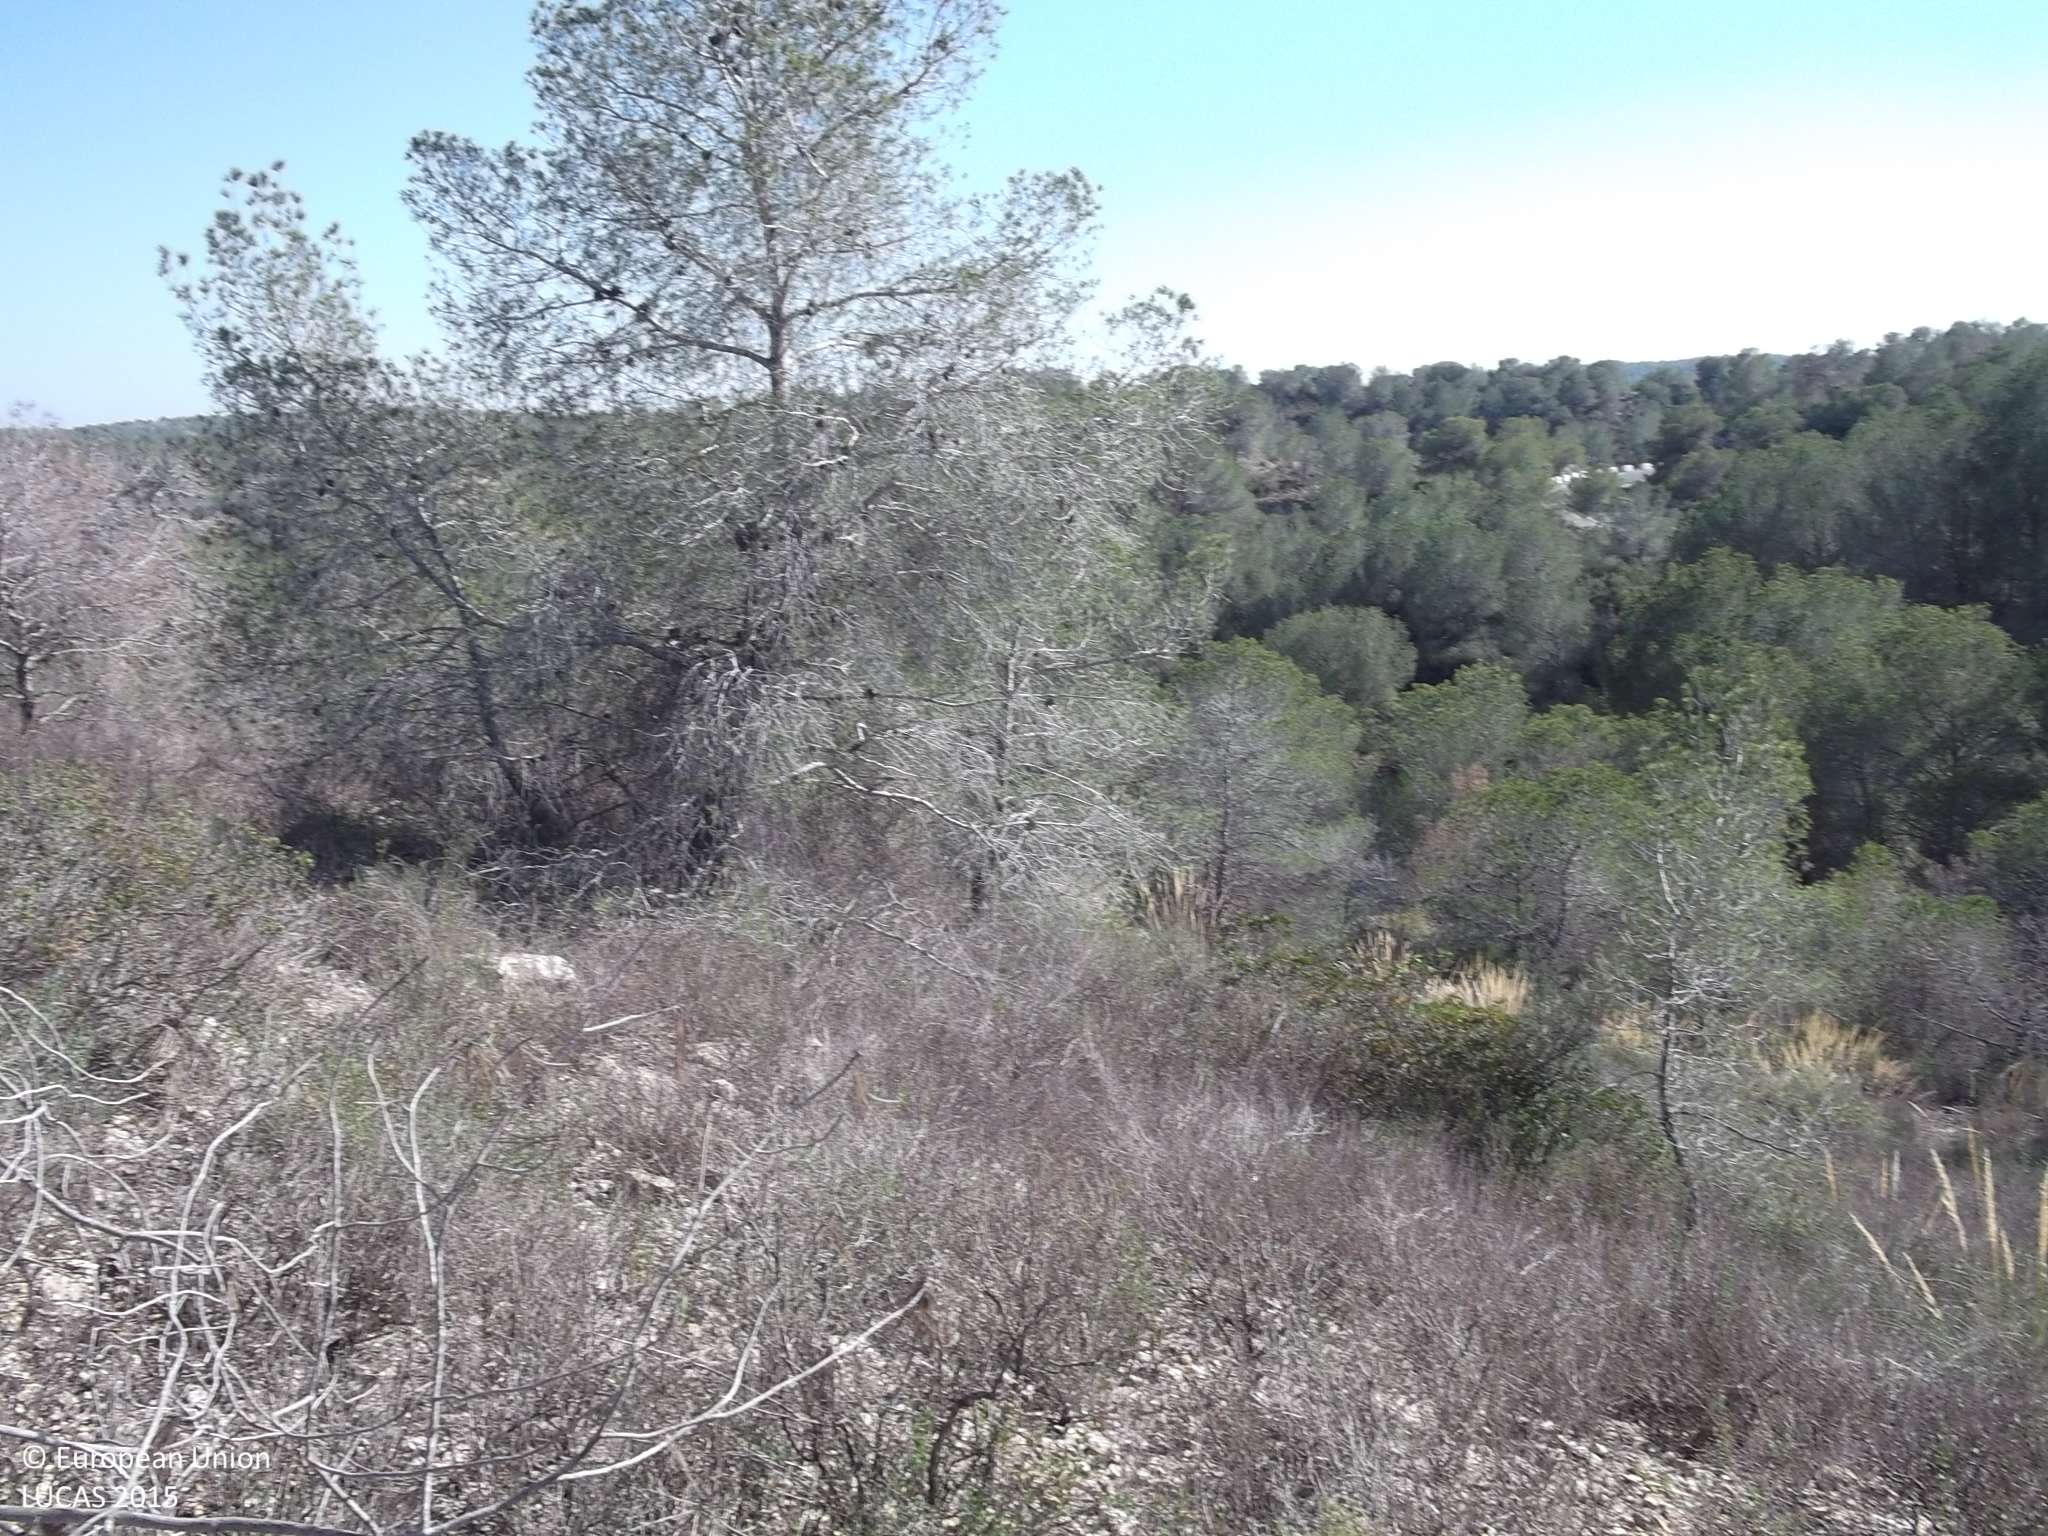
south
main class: Woodland
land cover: Pine dominated coniferous woodland
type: coniferous forest of the mediterranean region
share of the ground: 10 - 25 %
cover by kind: shrubs 30 %, consolidated bare surface 30 %, coniferous forest trees 20 %, herbaceous plants 20 %
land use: Semi-natural and natural areas not in use
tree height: > 5 m
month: May
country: ES
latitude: 37.9500
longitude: -0.8275
